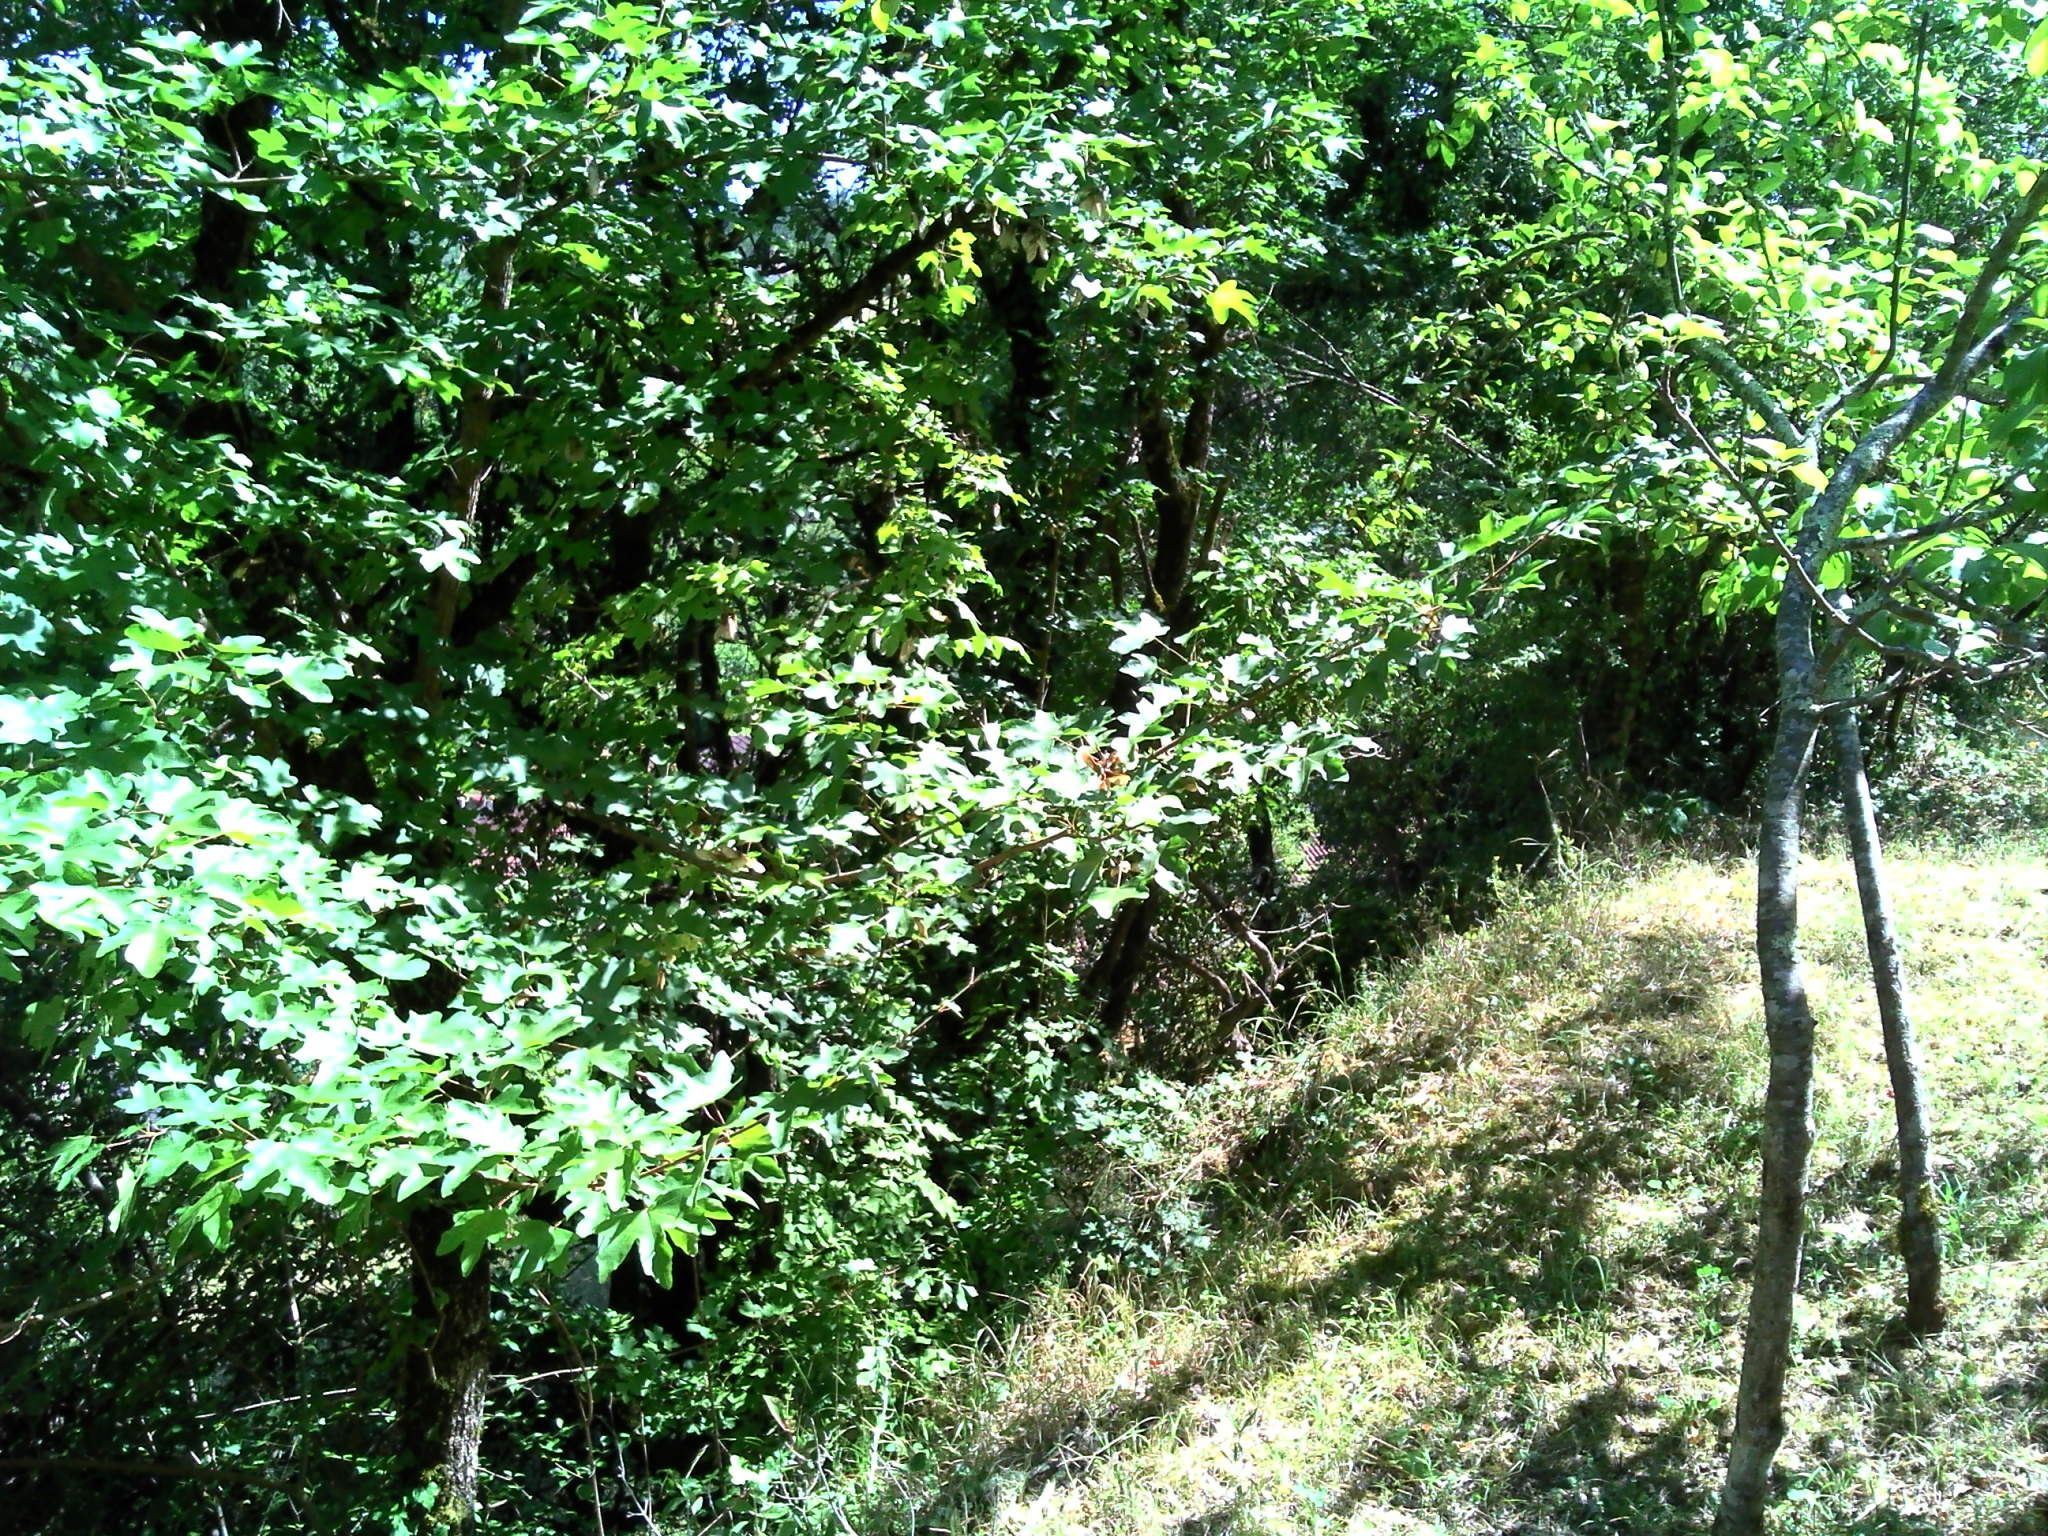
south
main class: Grassland
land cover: Grassland with sparse tree/shrub cover
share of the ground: > 75 %
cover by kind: herbaceous plants 95 %, broadleaved forest trees 5 %
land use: Residential
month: July
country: FR
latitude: 44.4687
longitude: 1.2355
